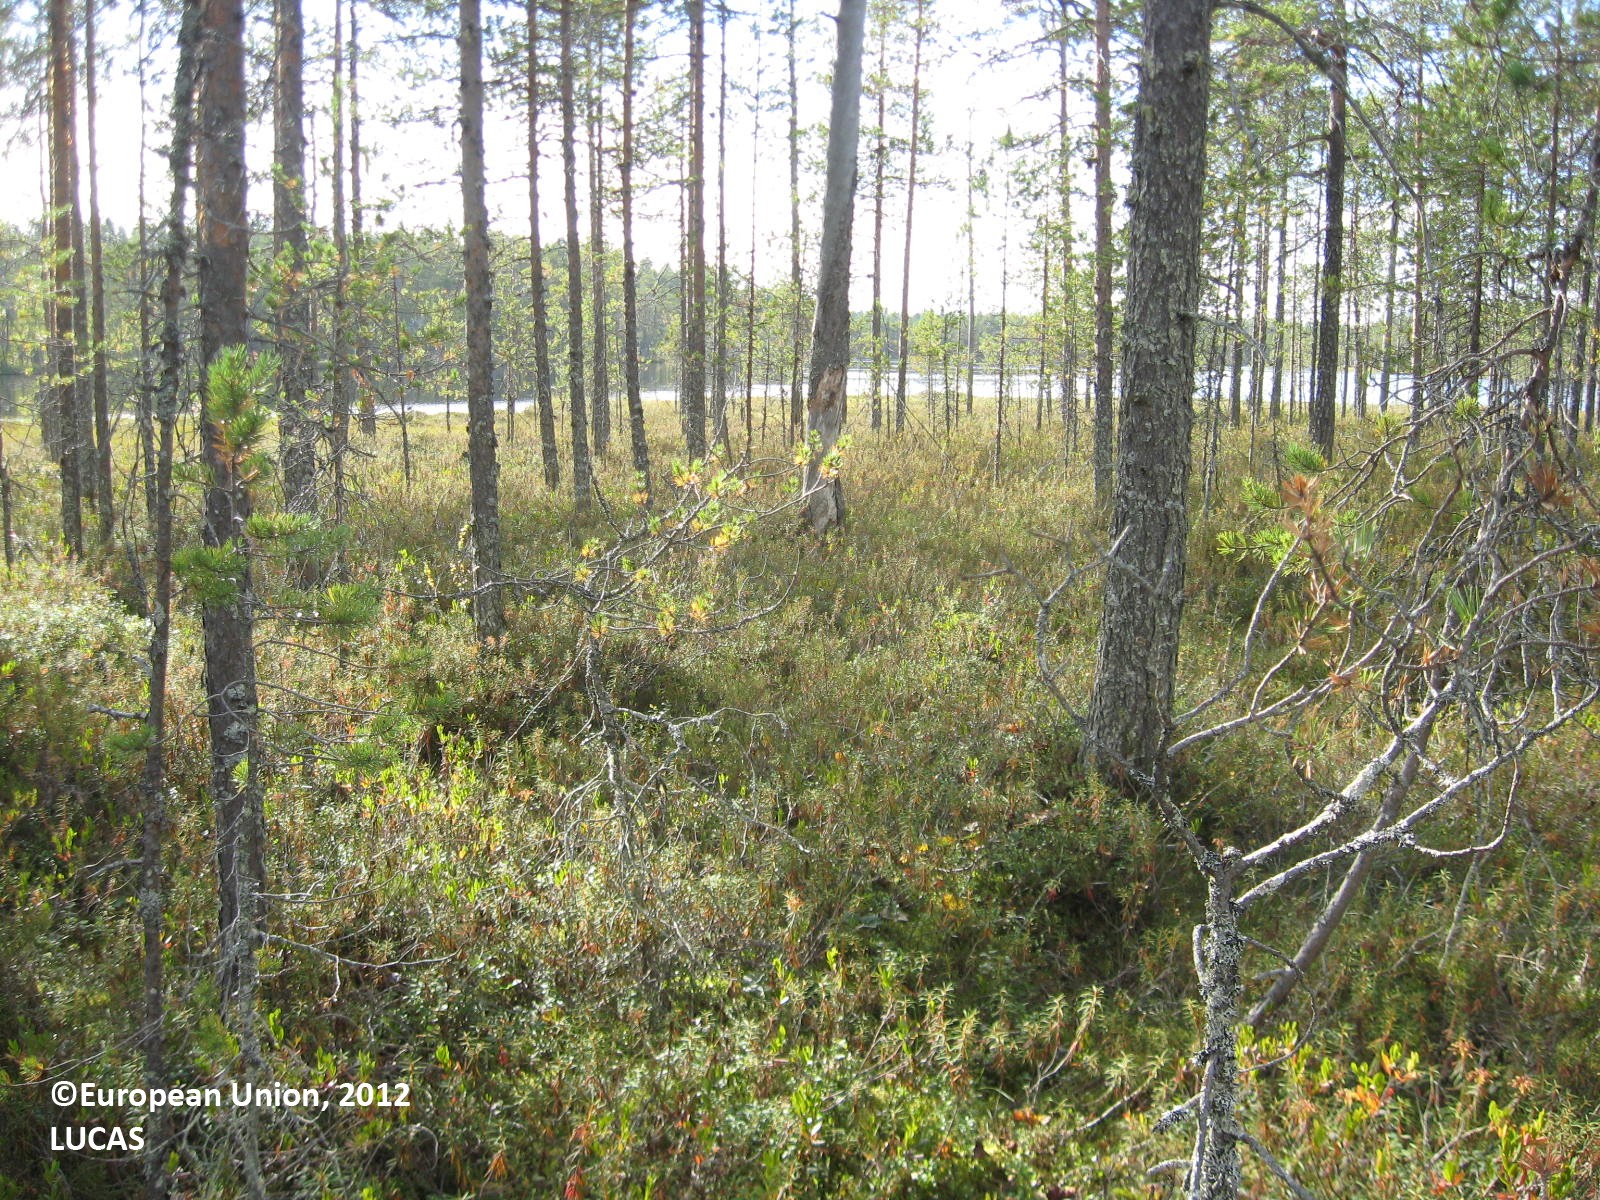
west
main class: Woodland
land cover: Pine dominated coniferous woodland
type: boreal forest
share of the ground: 50 - 75 %
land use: Semi-natural and natural areas not in use
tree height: > 5 m
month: August
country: FI
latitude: 63.8402
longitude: 29.2201
